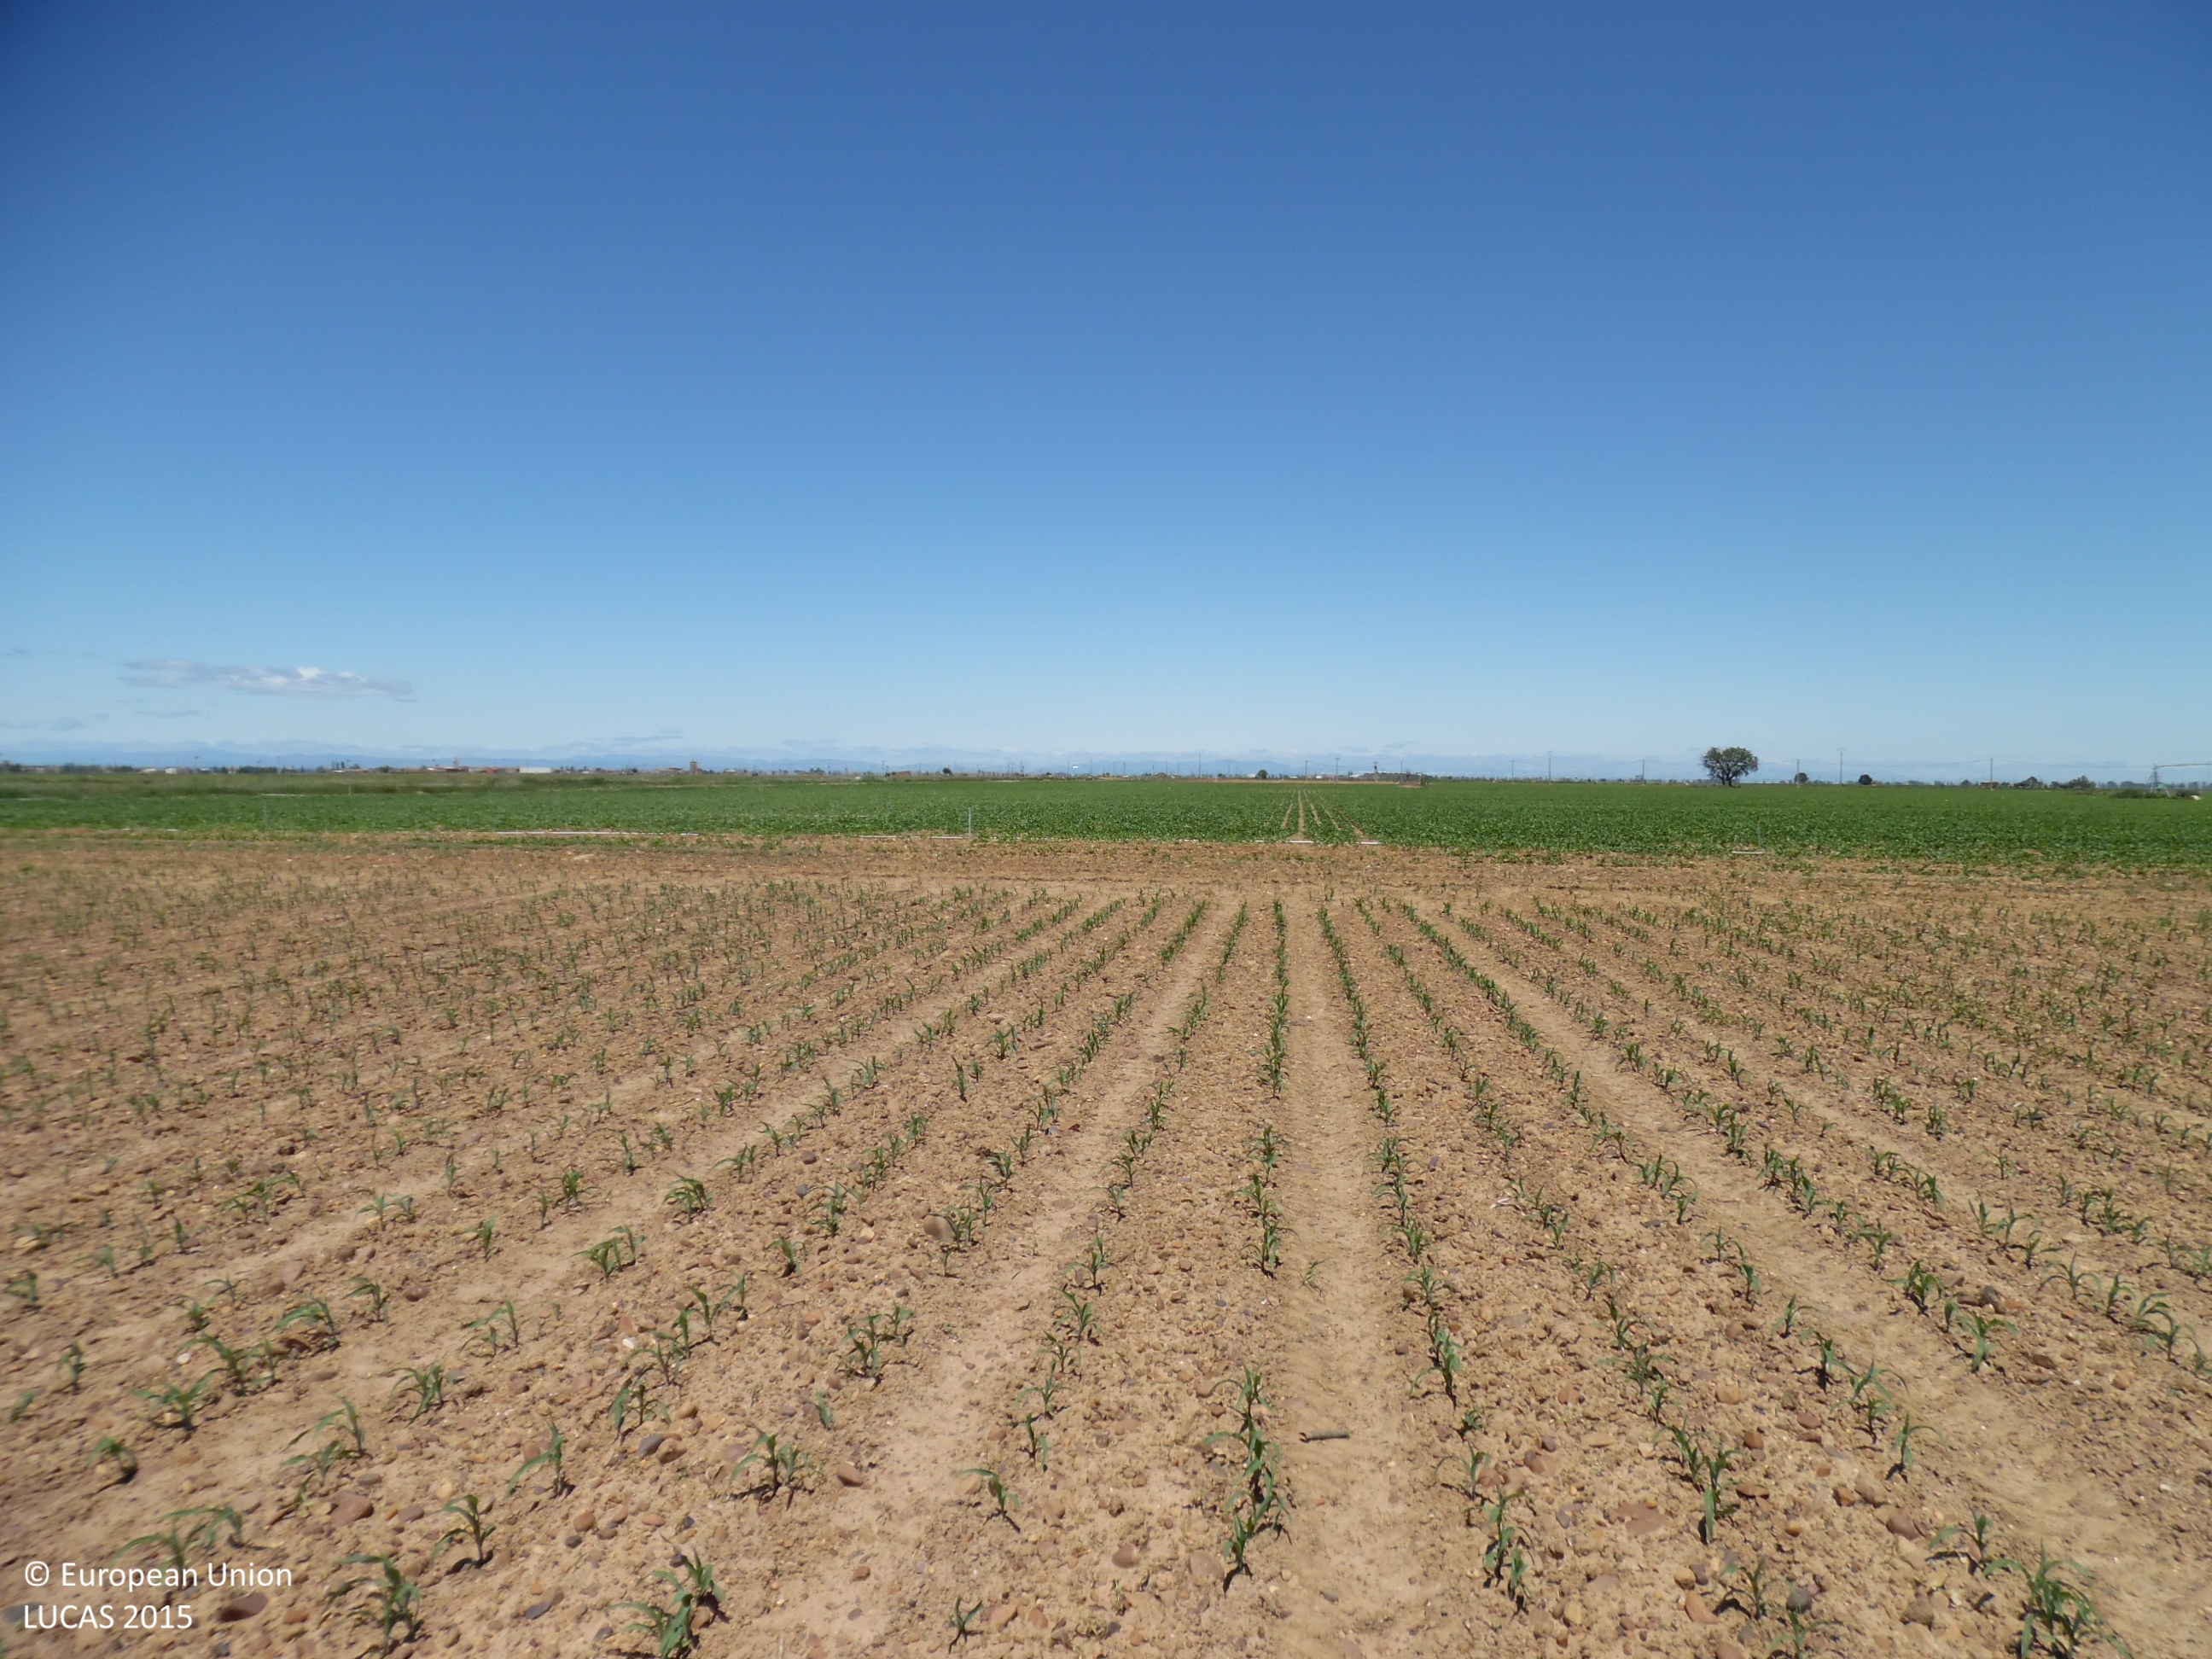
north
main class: Cropland
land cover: Maize
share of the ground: > 75 %
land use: Agriculture (excluding fallow land and kitchen gardens)
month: May
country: ES
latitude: 42.2796
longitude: -5.7269
